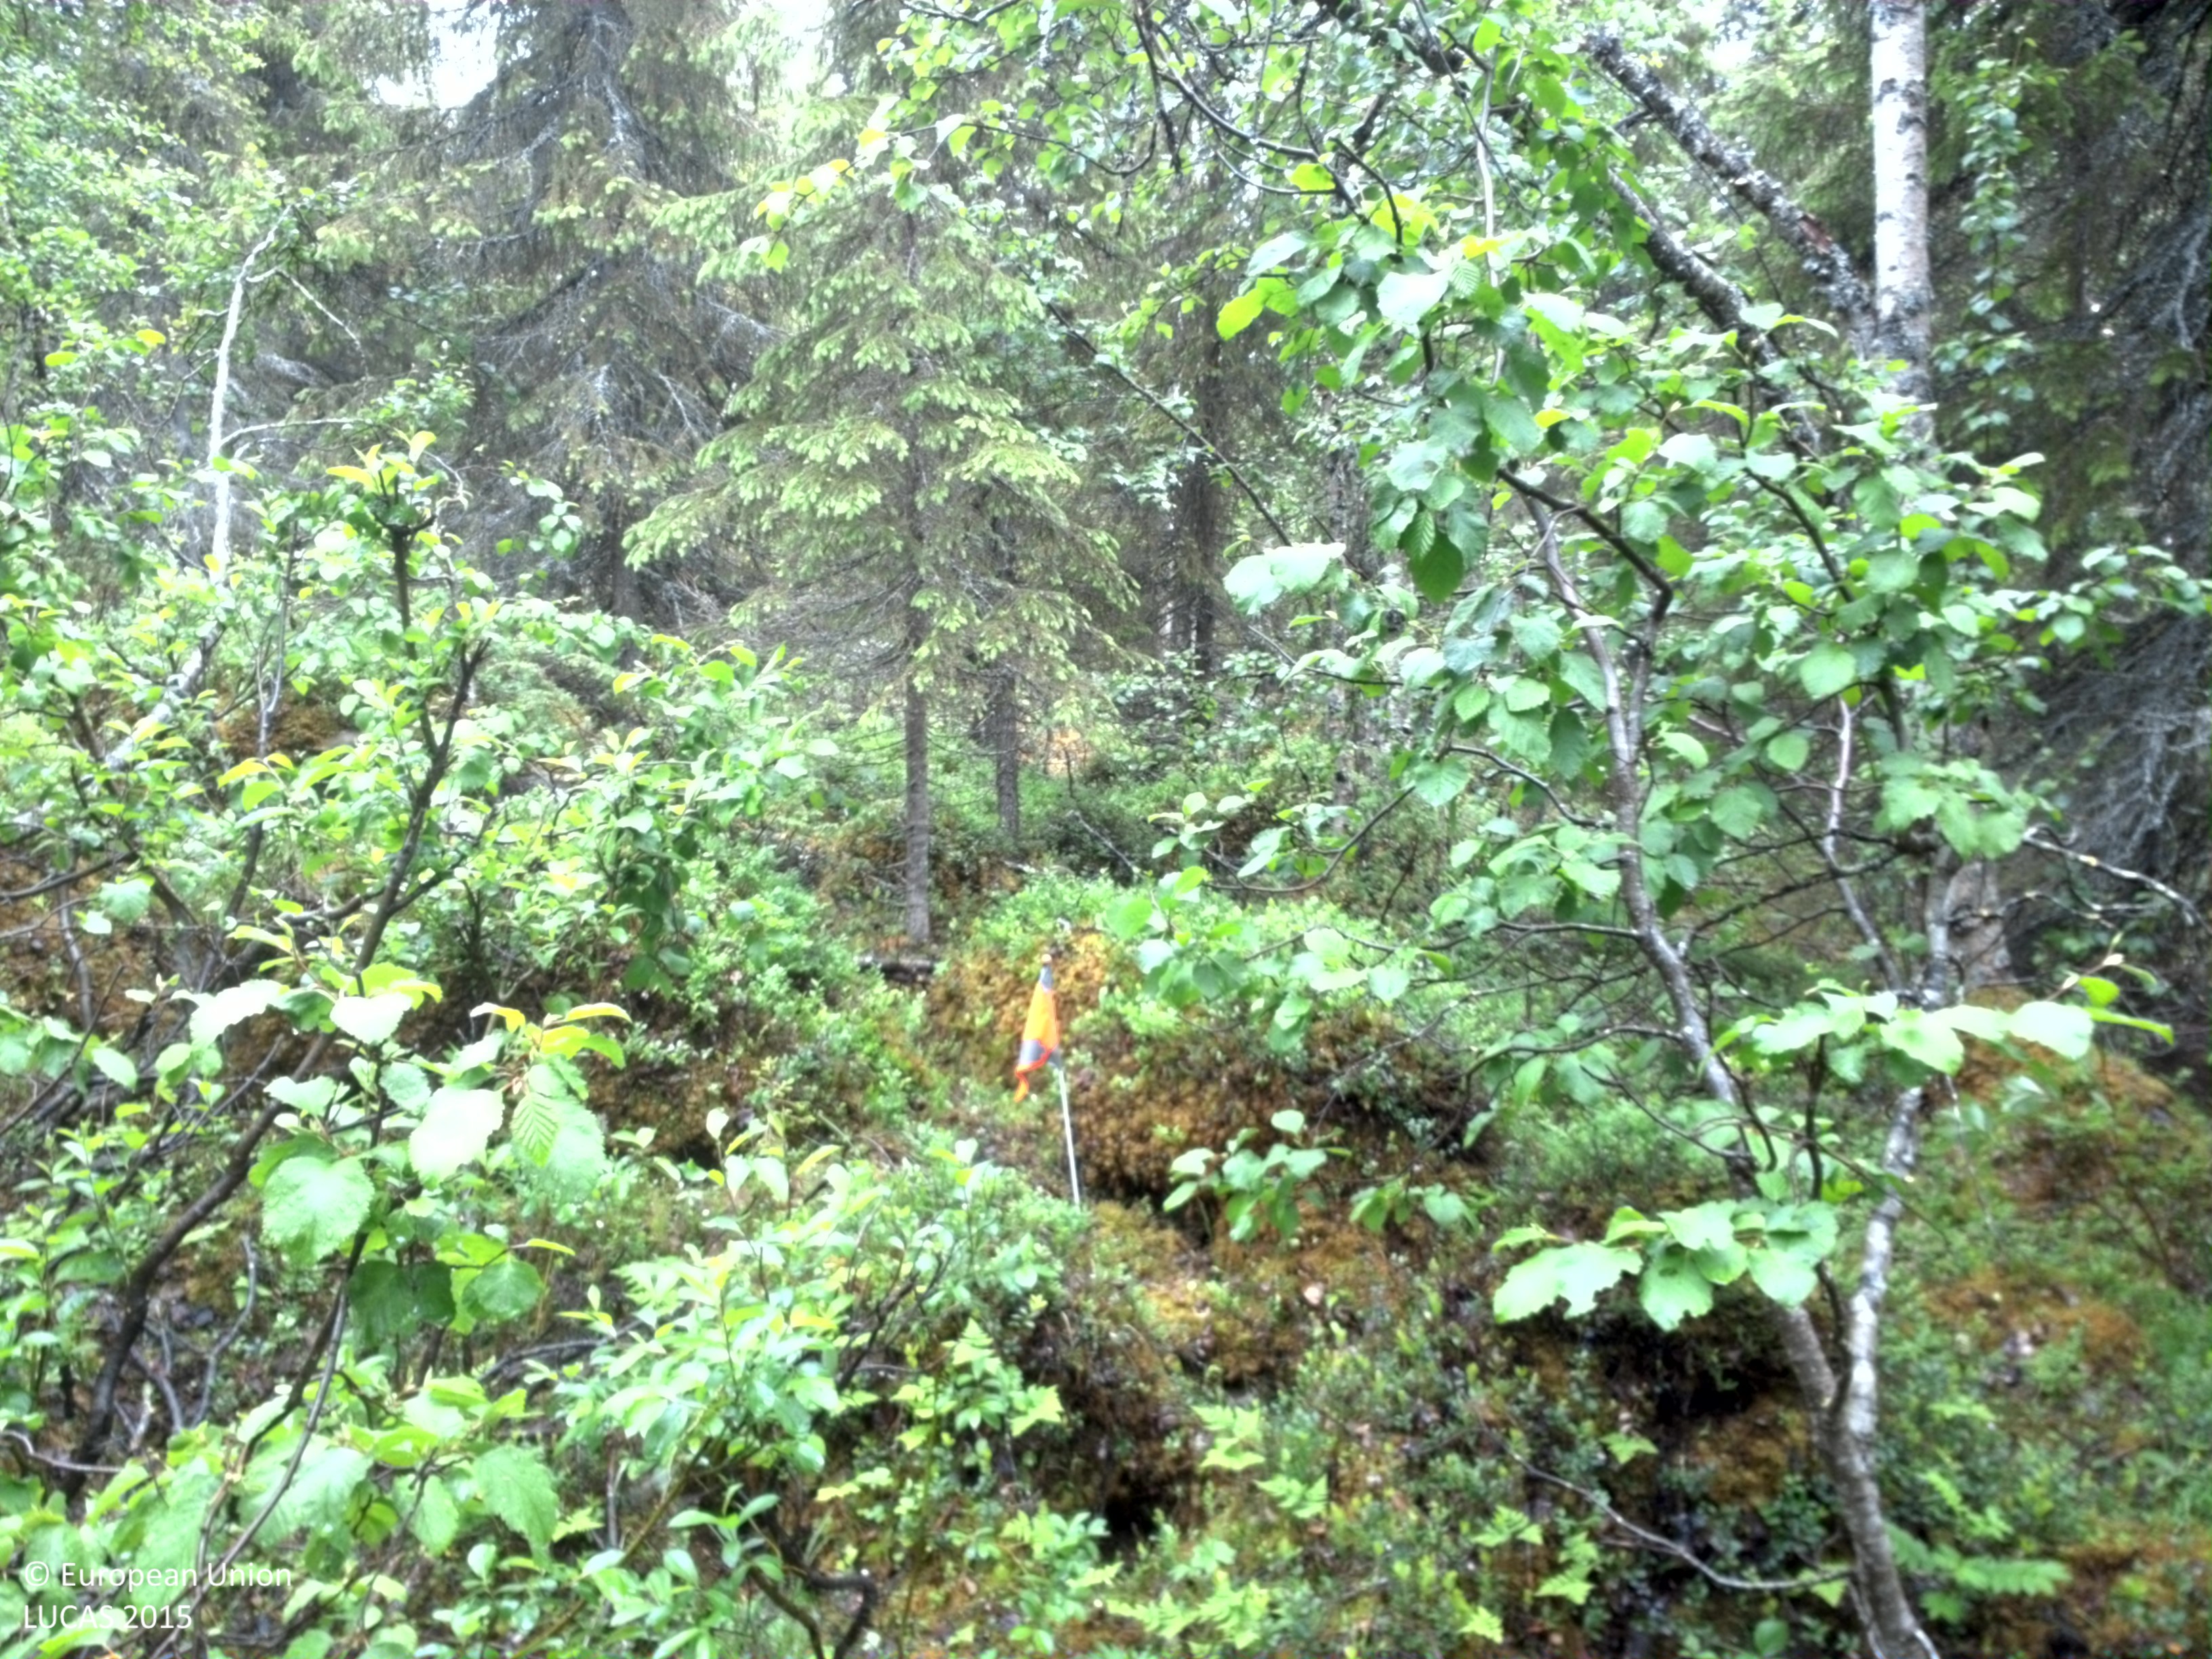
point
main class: Woodland
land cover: Spruce dominated mixed woodland
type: boreal forest
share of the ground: 50 - 75 %
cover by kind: shrubs 35 %, coniferous forest trees 25 %, broadleaved forest trees 25 %, lichens and mosses 10 %, herbaceous plants 5 %
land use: Amenities, museums, leisure
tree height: > 5 m
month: July
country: SE
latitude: 65.4717
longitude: 16.2444
